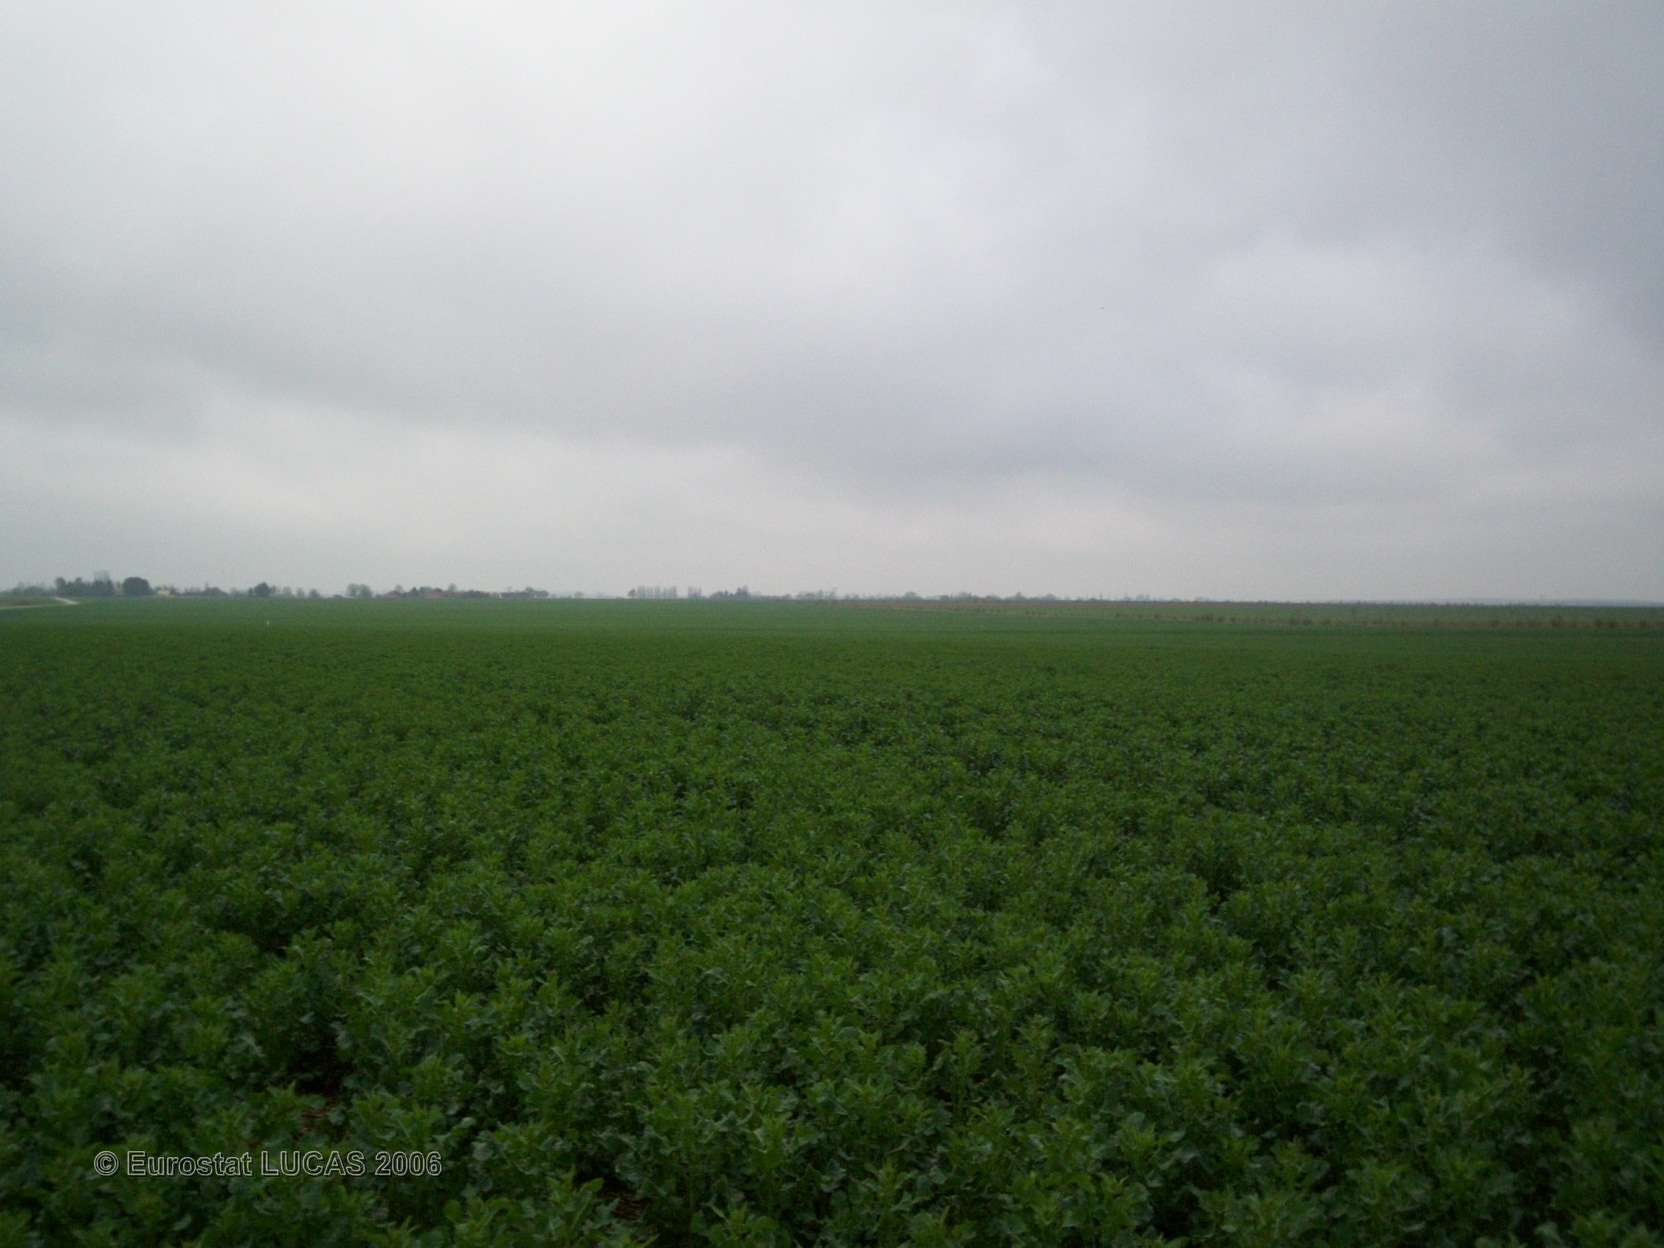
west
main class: Cropland
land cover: Rape and turnip rape
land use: Agriculture (excluding fallow land and kitchen gardens)
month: April
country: FR
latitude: 49.2135
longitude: 1.0139
